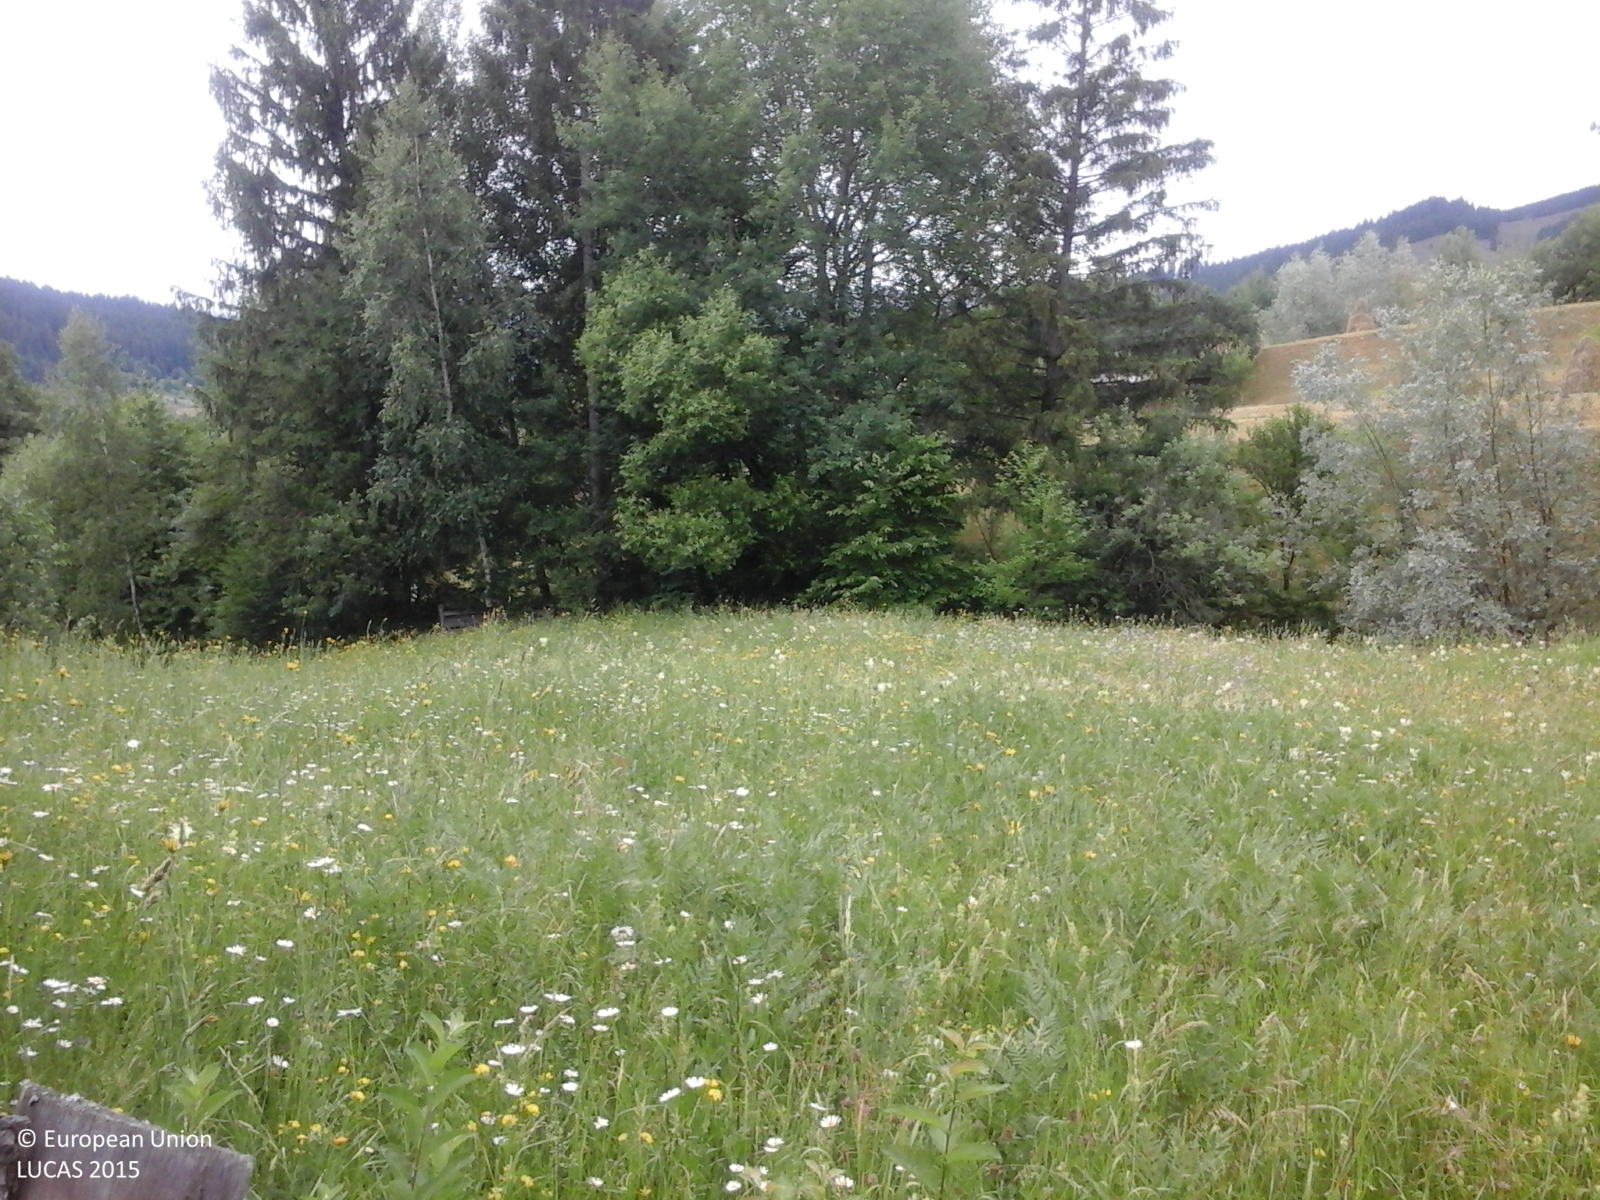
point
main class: Grassland
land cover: Grassland without tree/shrub cover
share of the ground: > 75 %
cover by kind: herbaceous plants 100 %
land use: Agriculture (excluding fallow land and kitchen gardens)
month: June
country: RO
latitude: 47.4963
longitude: 25.8004
